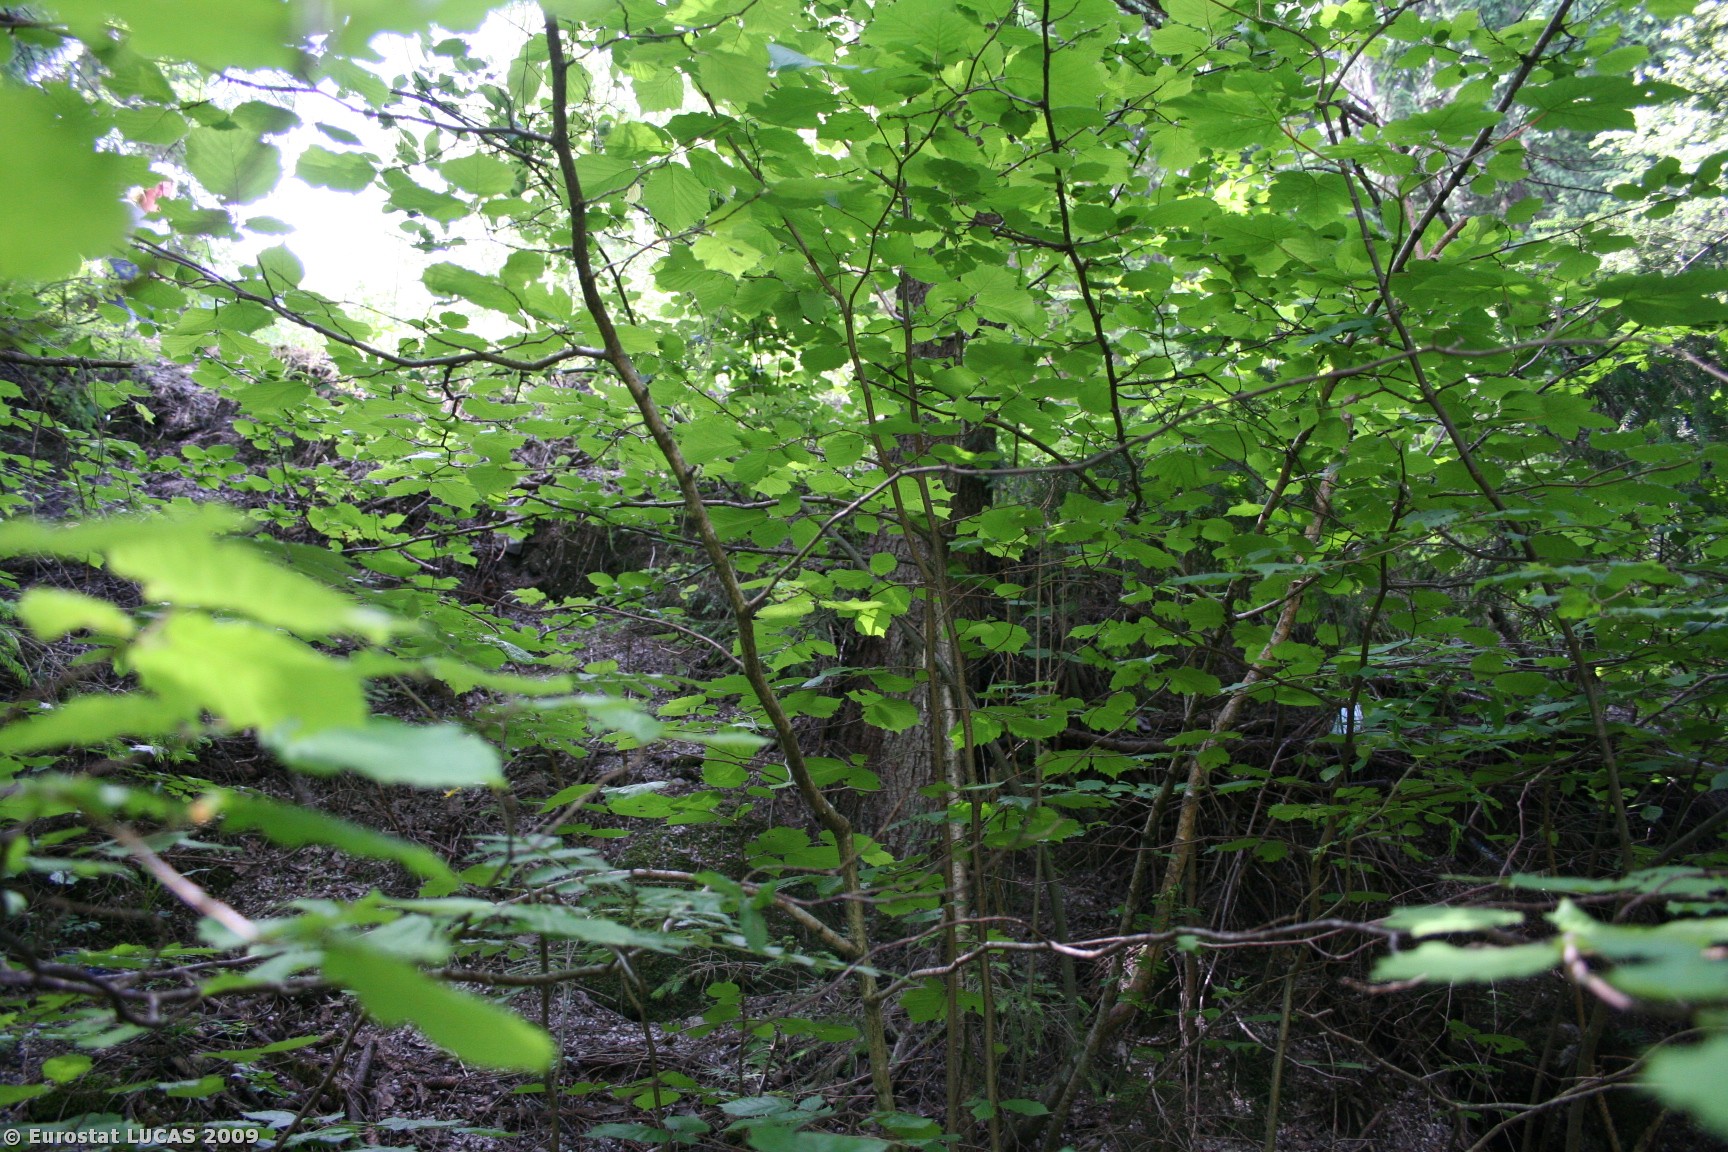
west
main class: Woodland
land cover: Coniferous woodland
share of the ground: 50 - 75 %
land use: Forestry
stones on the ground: < 10 %
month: June
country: AT
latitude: 47.2896
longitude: 11.8628
